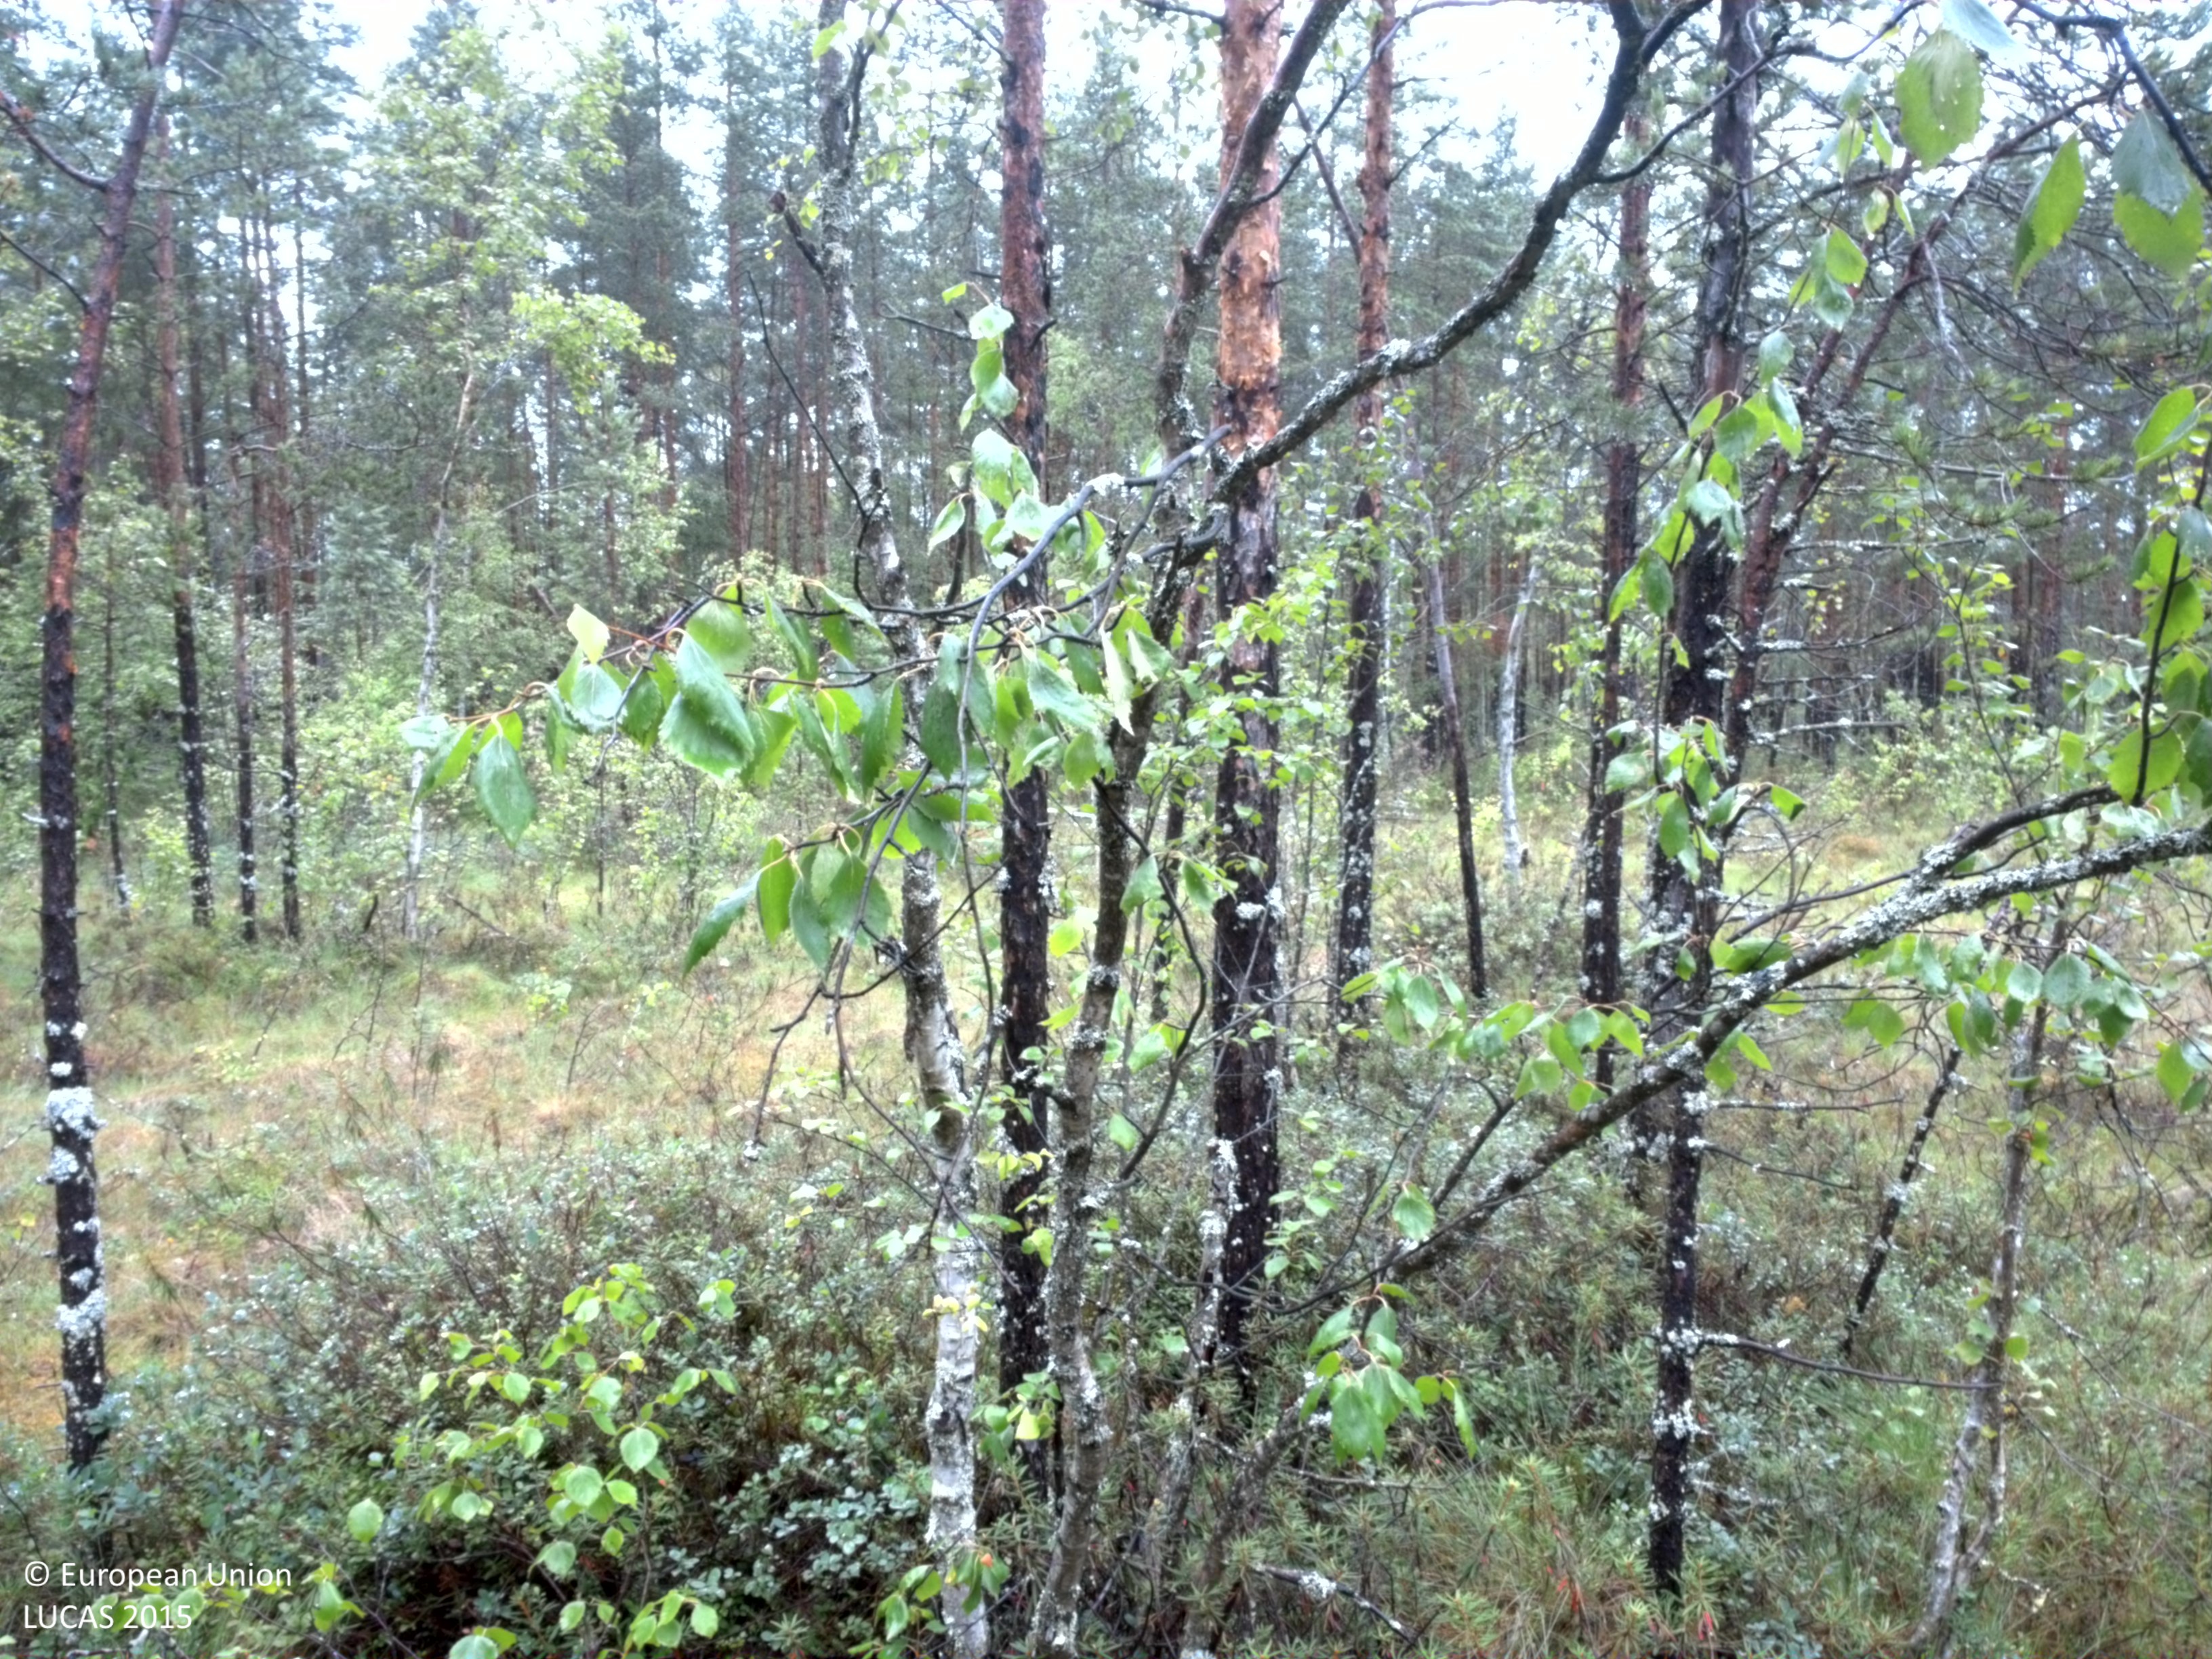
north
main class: Woodland
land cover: Other mixed woodland
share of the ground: 25 - 50 %
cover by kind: herbaceous plants 40 %, coniferous forest trees 20 %, broadleaved forest trees 20 %, shrubs 20 %
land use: Semi-natural and natural areas not in use
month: August
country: SE
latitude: 64.6713
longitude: 21.0198
